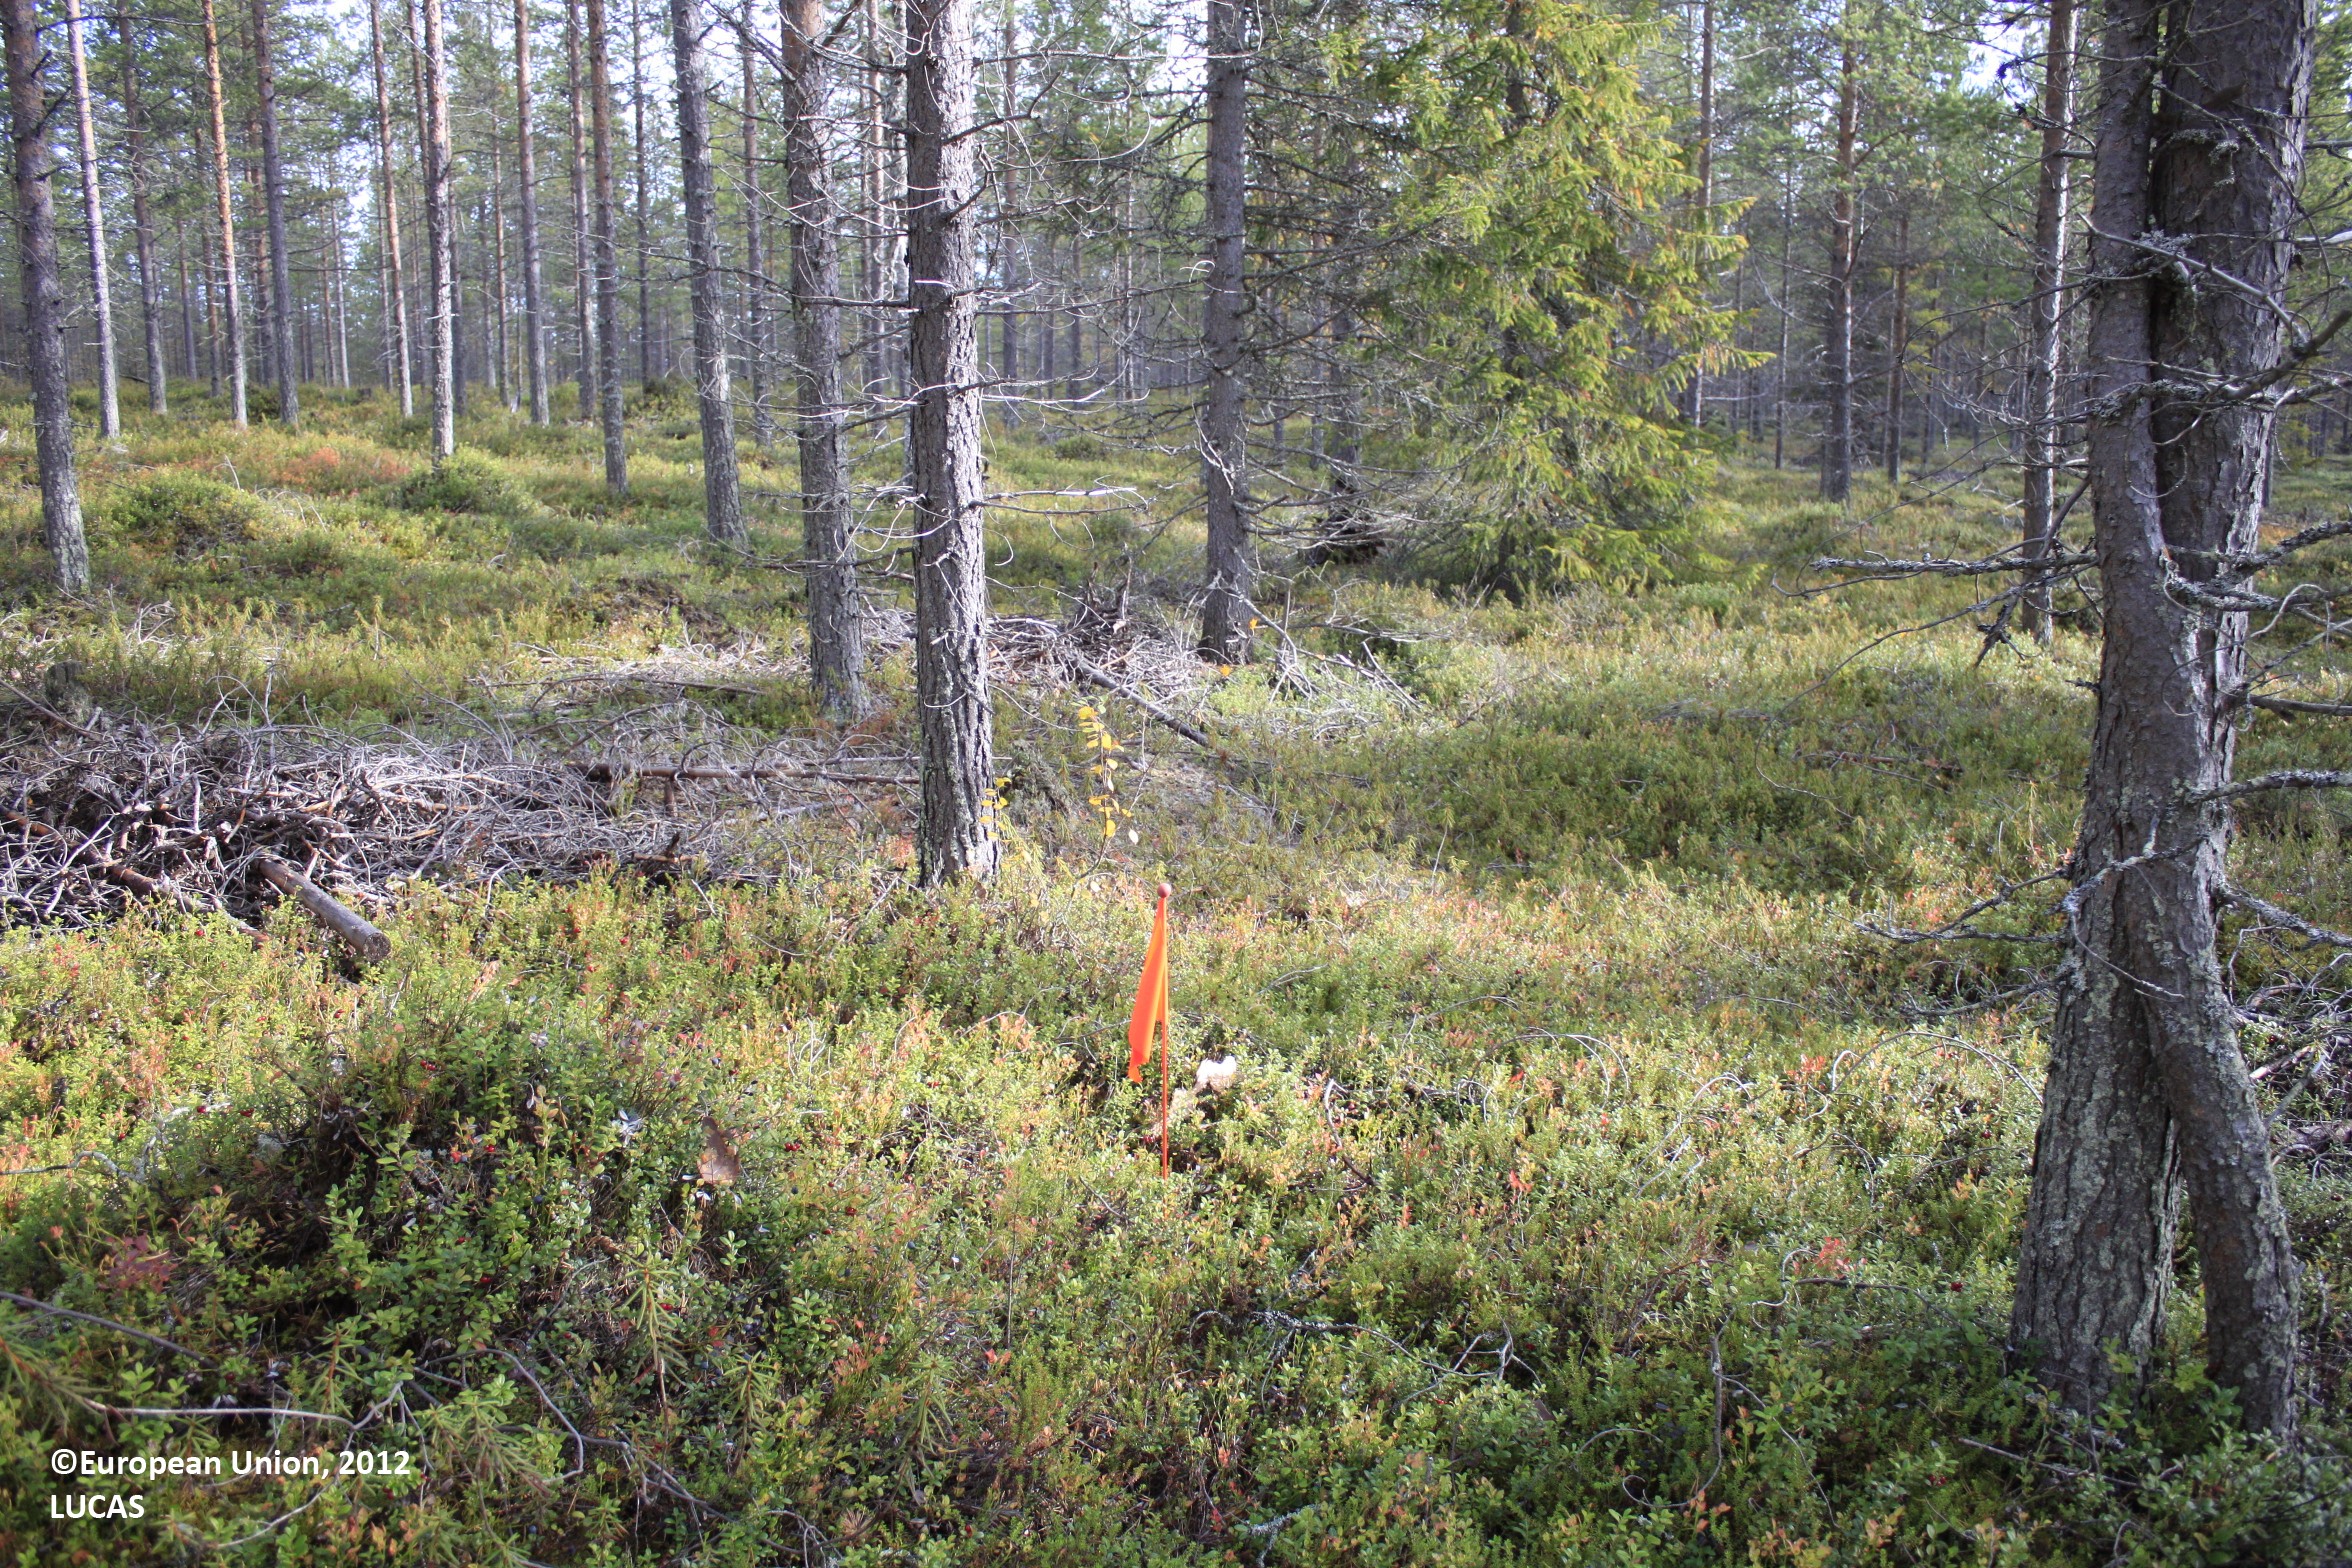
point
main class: Woodland
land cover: Pine dominated coniferous woodland
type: boreal forest
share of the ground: 25 - 50 %
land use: Forestry
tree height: > 5 m
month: September
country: FI
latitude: 66.0070
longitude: 27.2842
